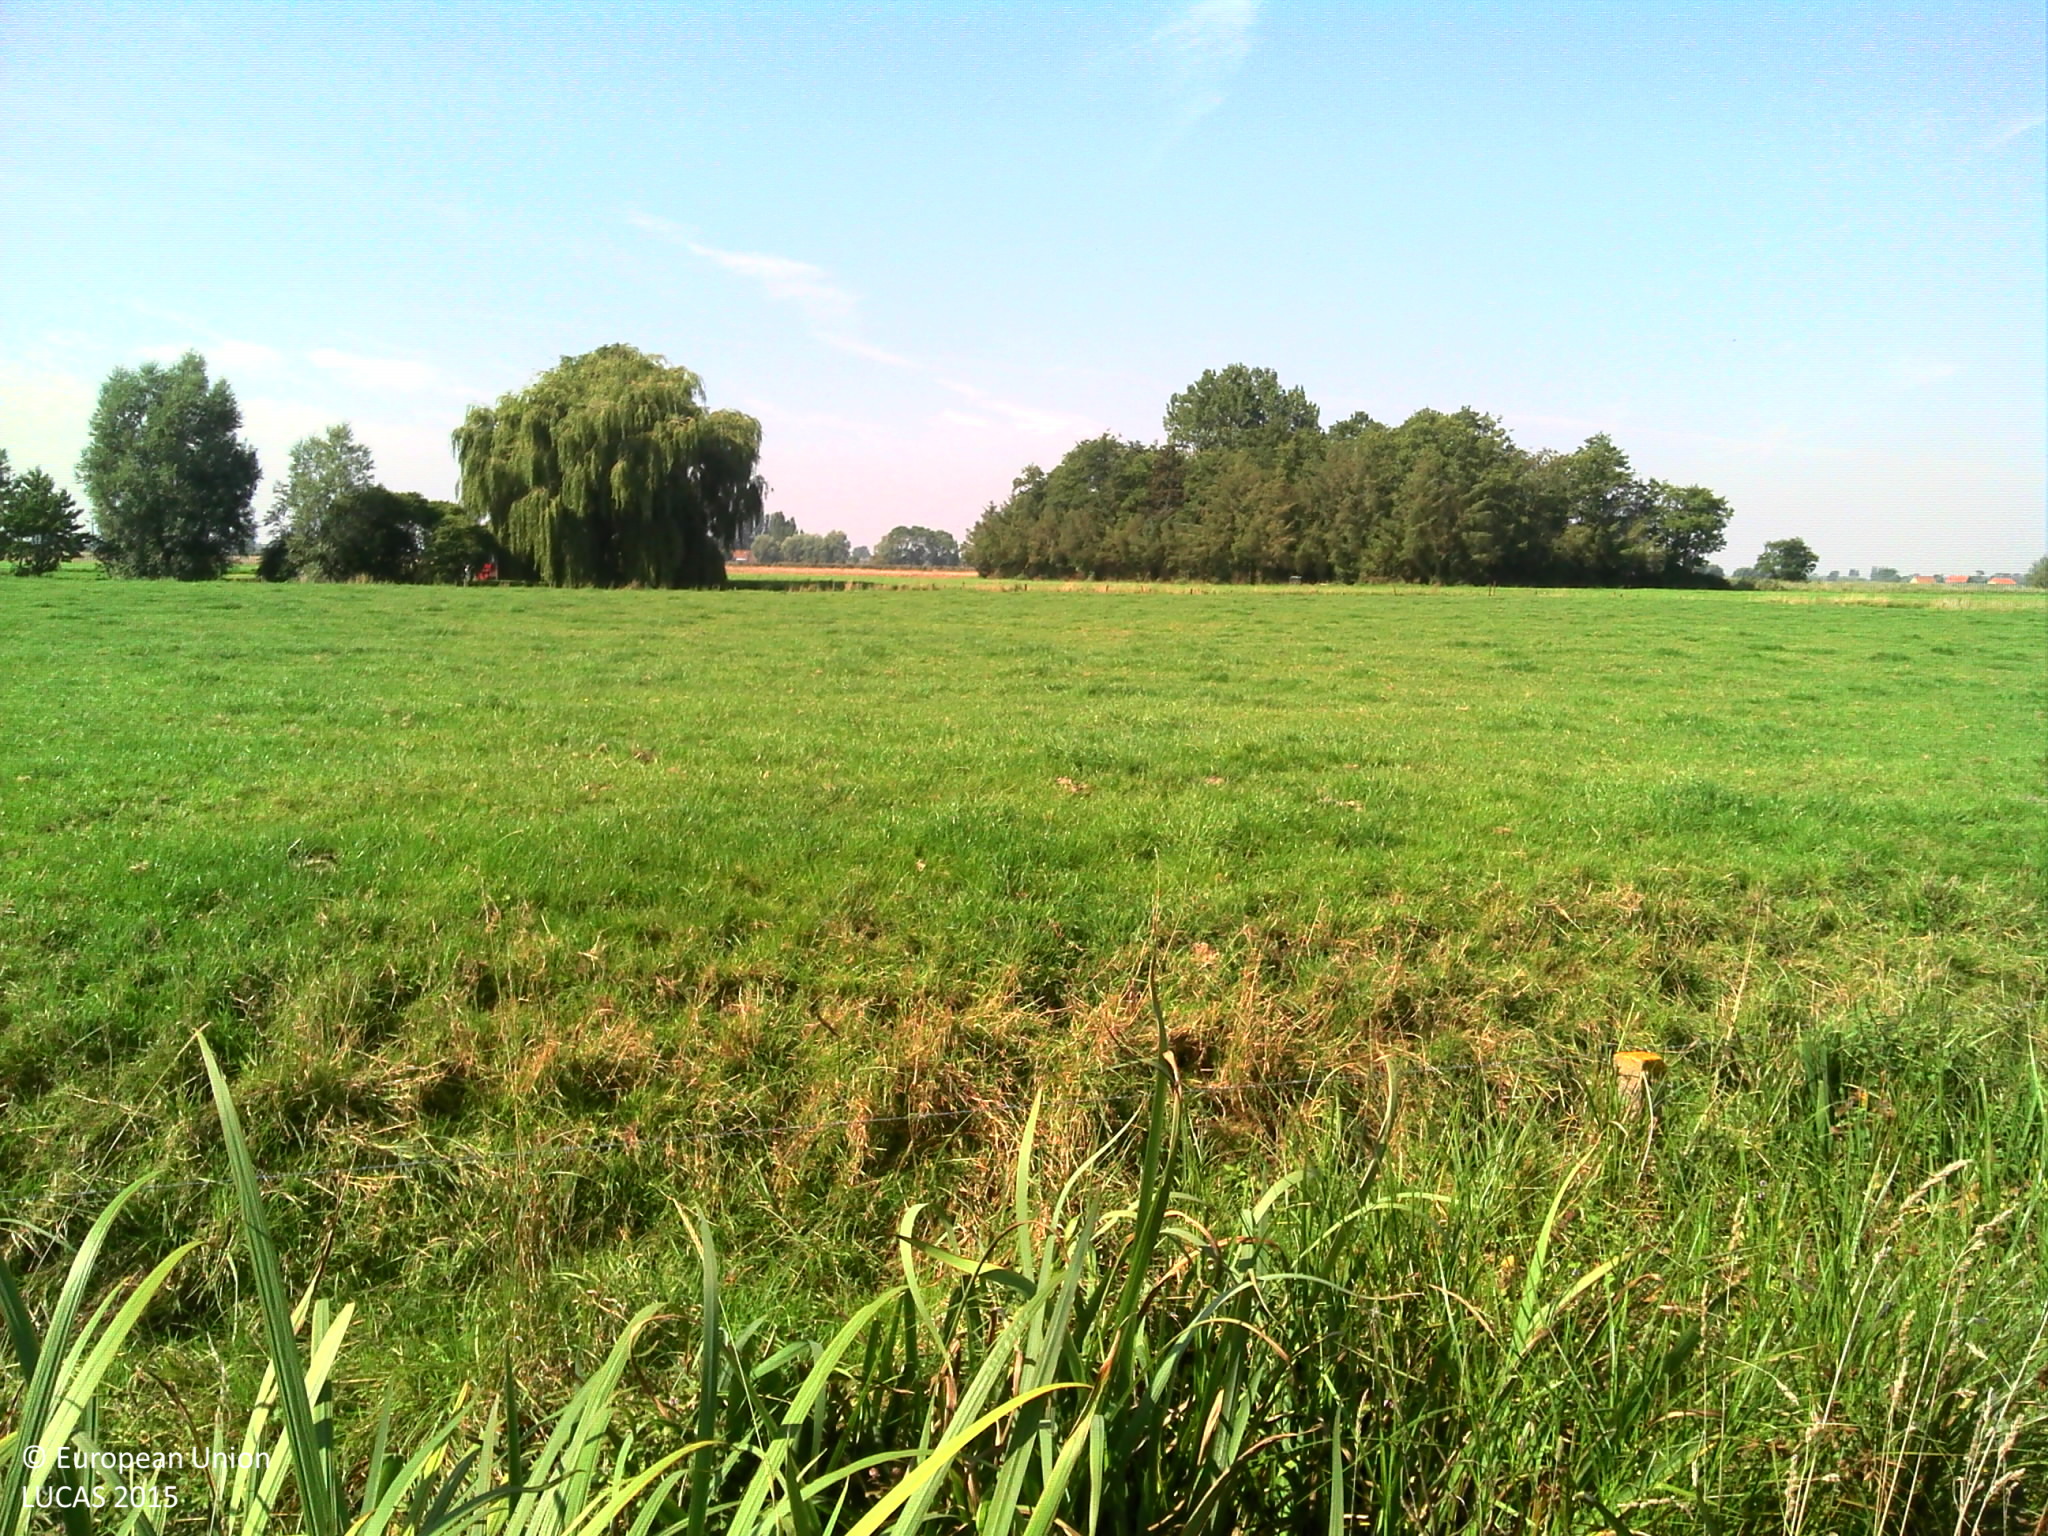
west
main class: Grassland
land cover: Grassland without tree/shrub cover
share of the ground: > 75 %
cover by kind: herbaceous plants 100 %
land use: Agriculture (excluding fallow land and kitchen gardens)
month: September
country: BE
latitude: 51.0031
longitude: 2.7922
